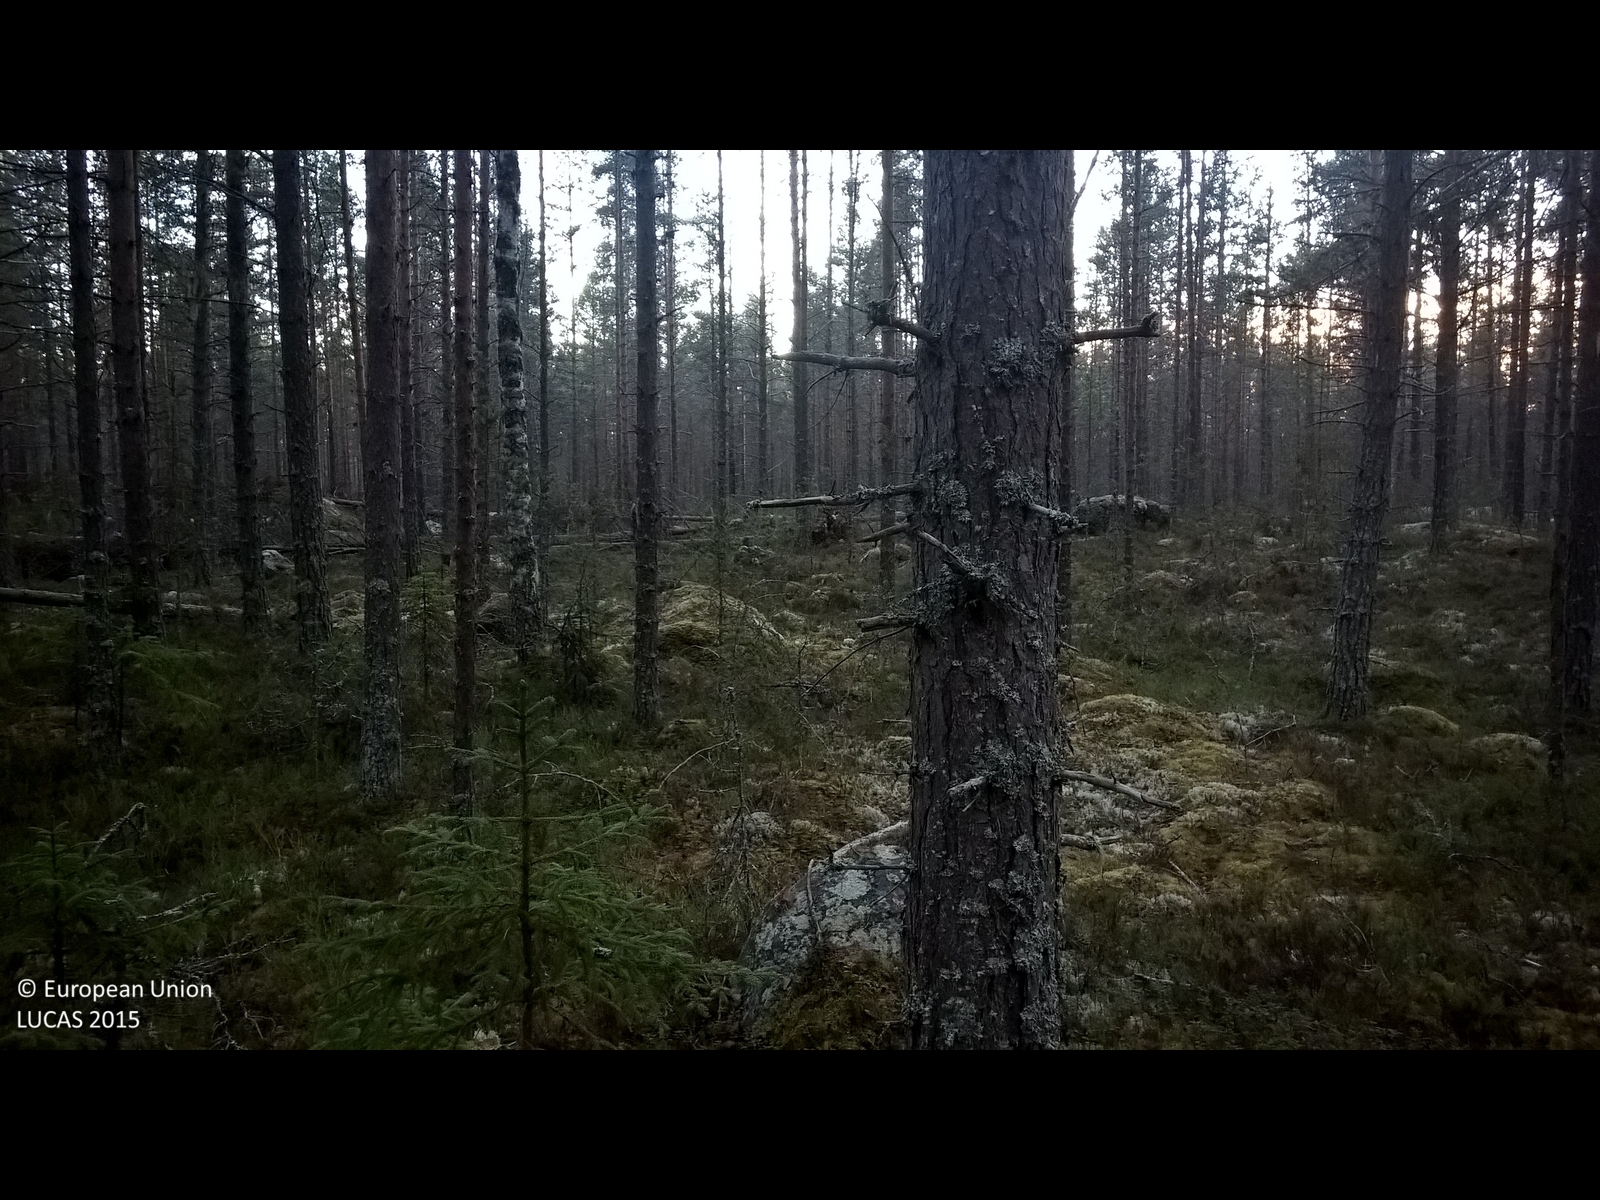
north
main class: Woodland
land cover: Pine dominated coniferous woodland
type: boreal forest
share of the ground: > 75 %
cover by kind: coniferous forest trees 80 %, shrubs 10 %, lichens and mosses 10 %
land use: Forestry
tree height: > 5 m
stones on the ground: < 10 %
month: November
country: SE
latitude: 62.4631
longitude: 15.3507
